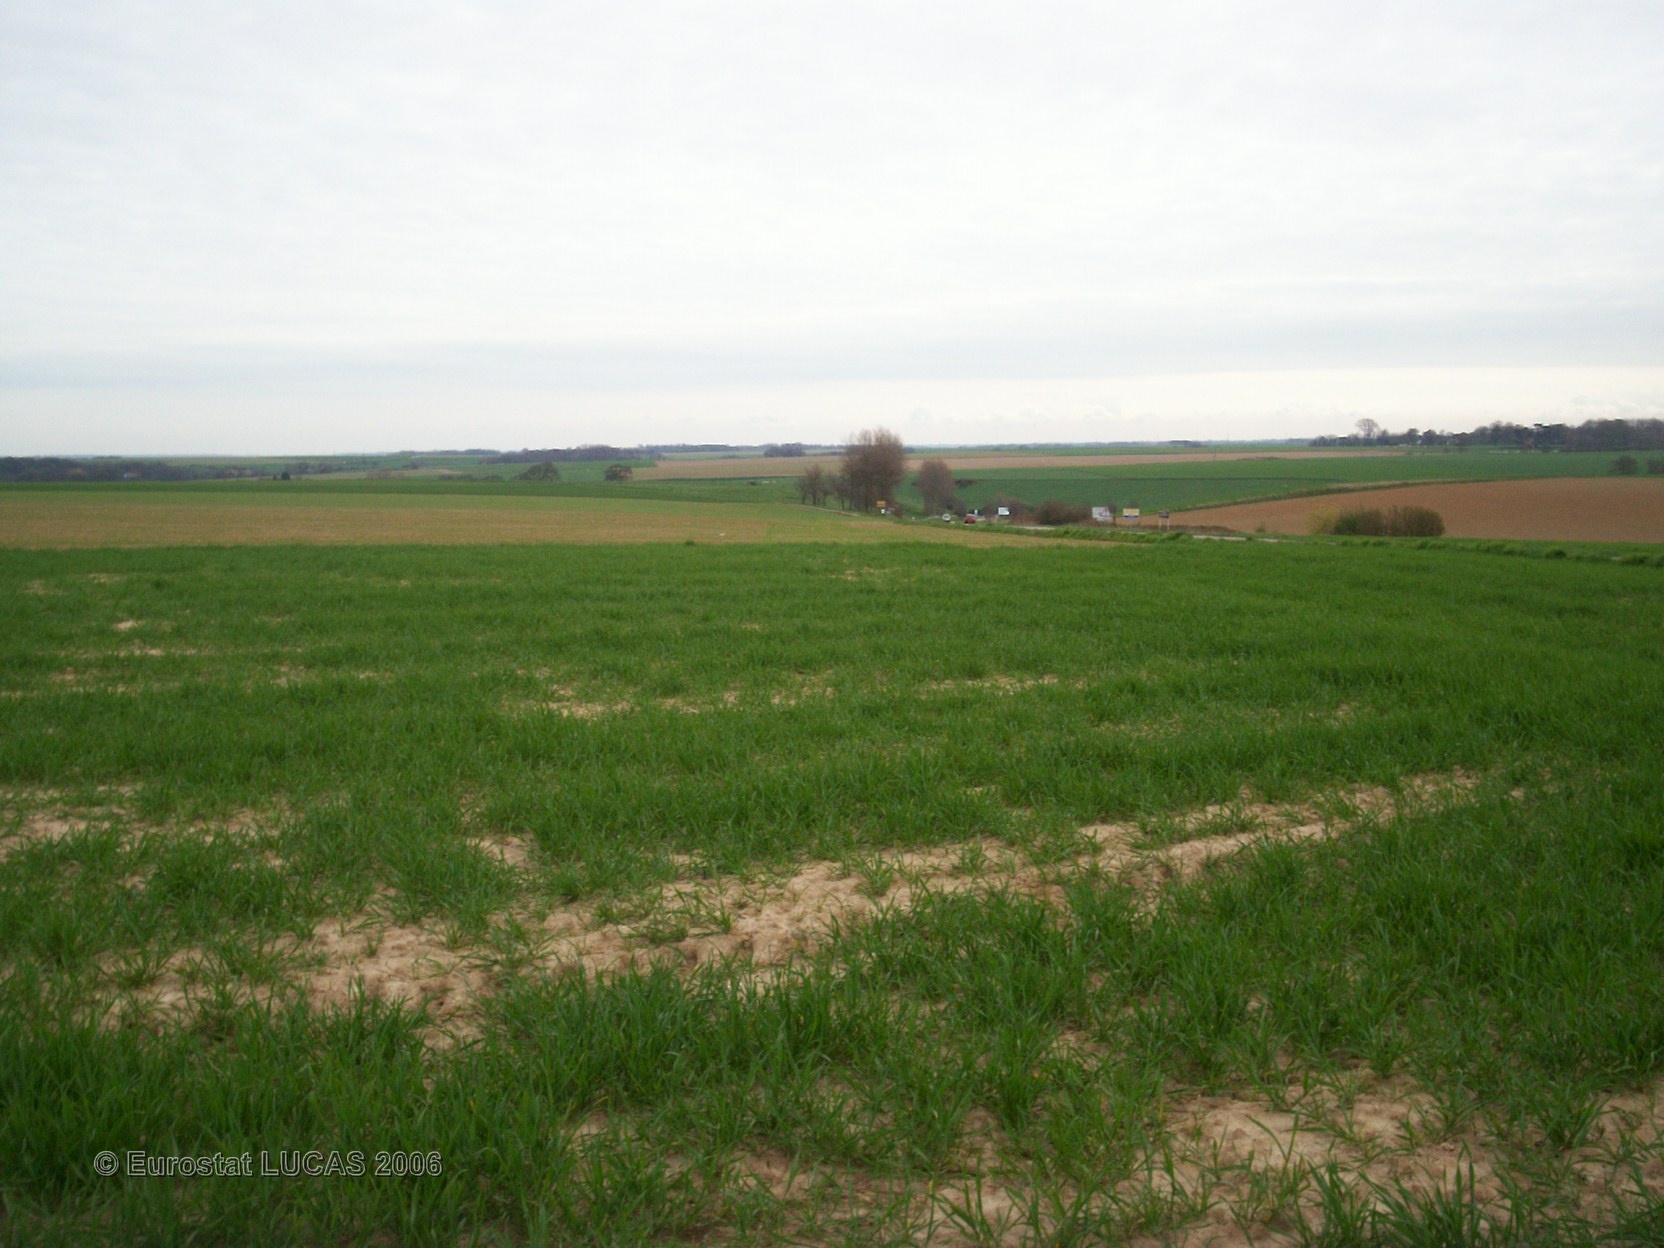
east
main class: Cropland
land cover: Common wheat
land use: Agriculture (excluding fallow land and kitchen gardens)
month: April
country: FR
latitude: 49.8642
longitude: 0.7797
